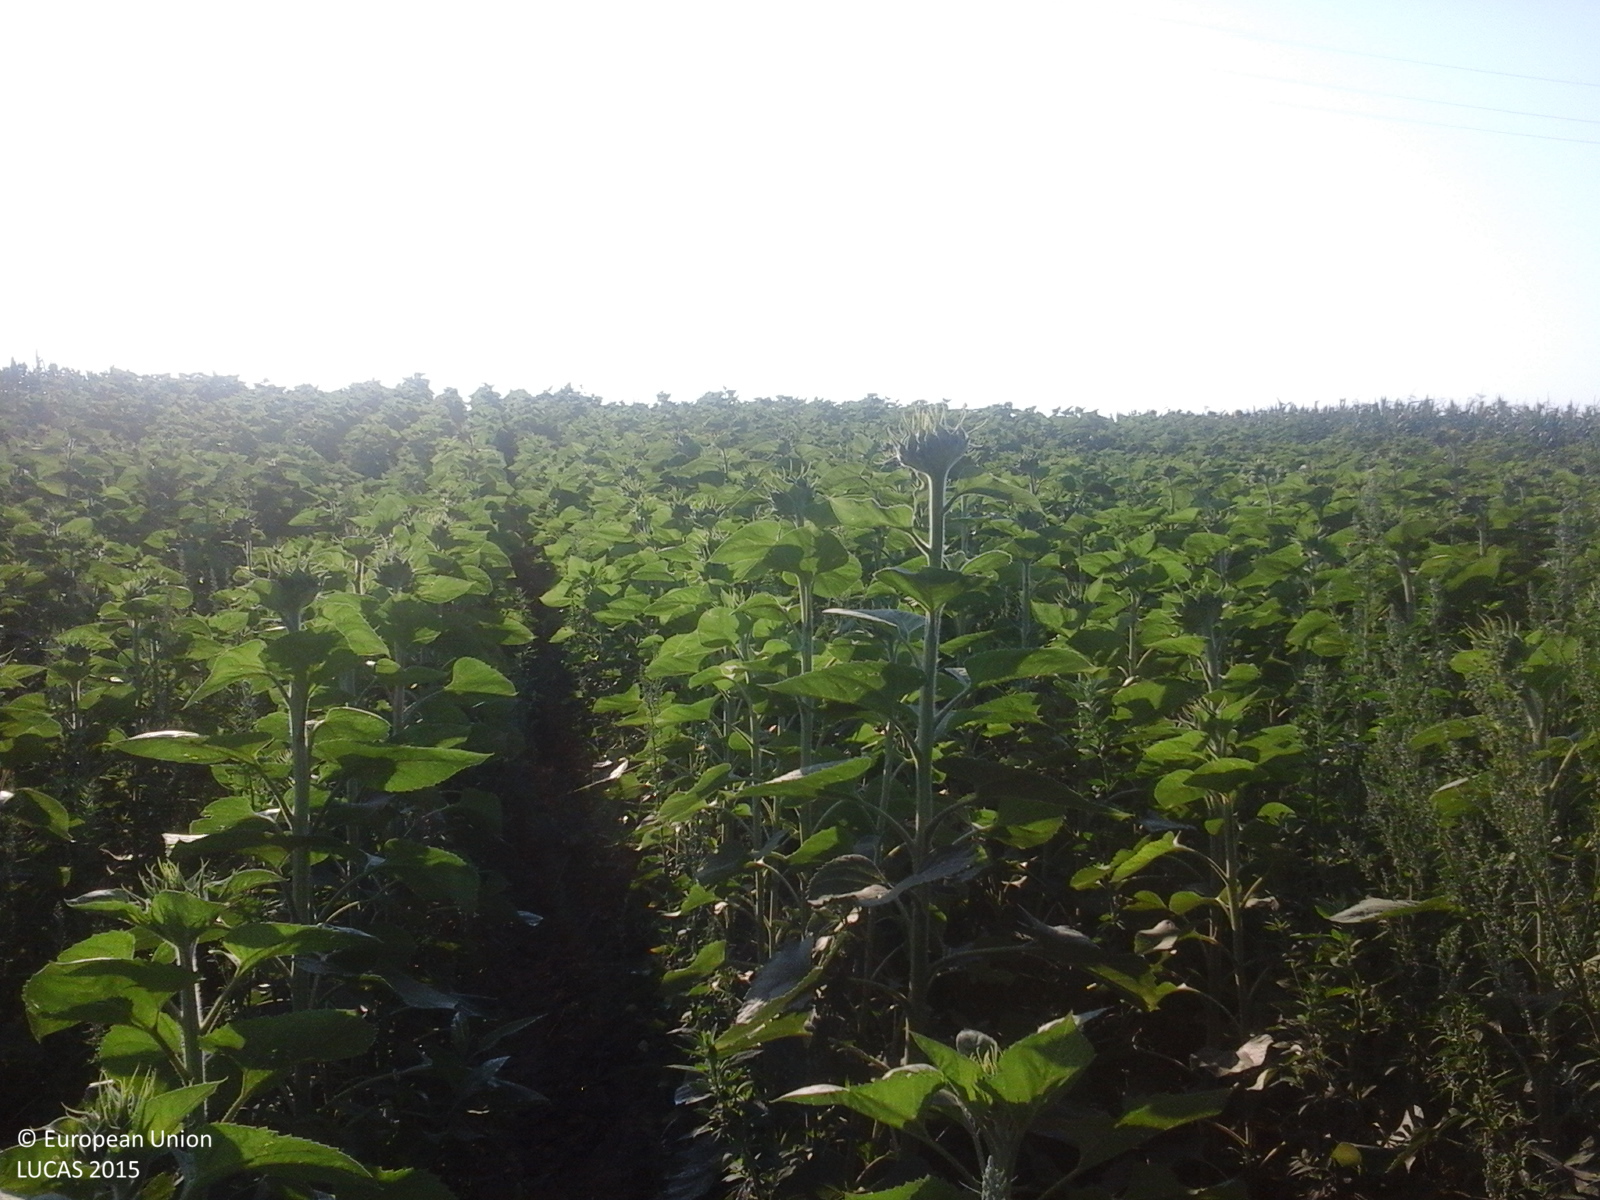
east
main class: Cropland
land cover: Sunflower
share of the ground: > 75 %
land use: Agriculture (excluding fallow land and kitchen gardens)
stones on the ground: < 10 %
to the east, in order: Sunflower
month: July
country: RO
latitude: 44.4836
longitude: 24.7233
